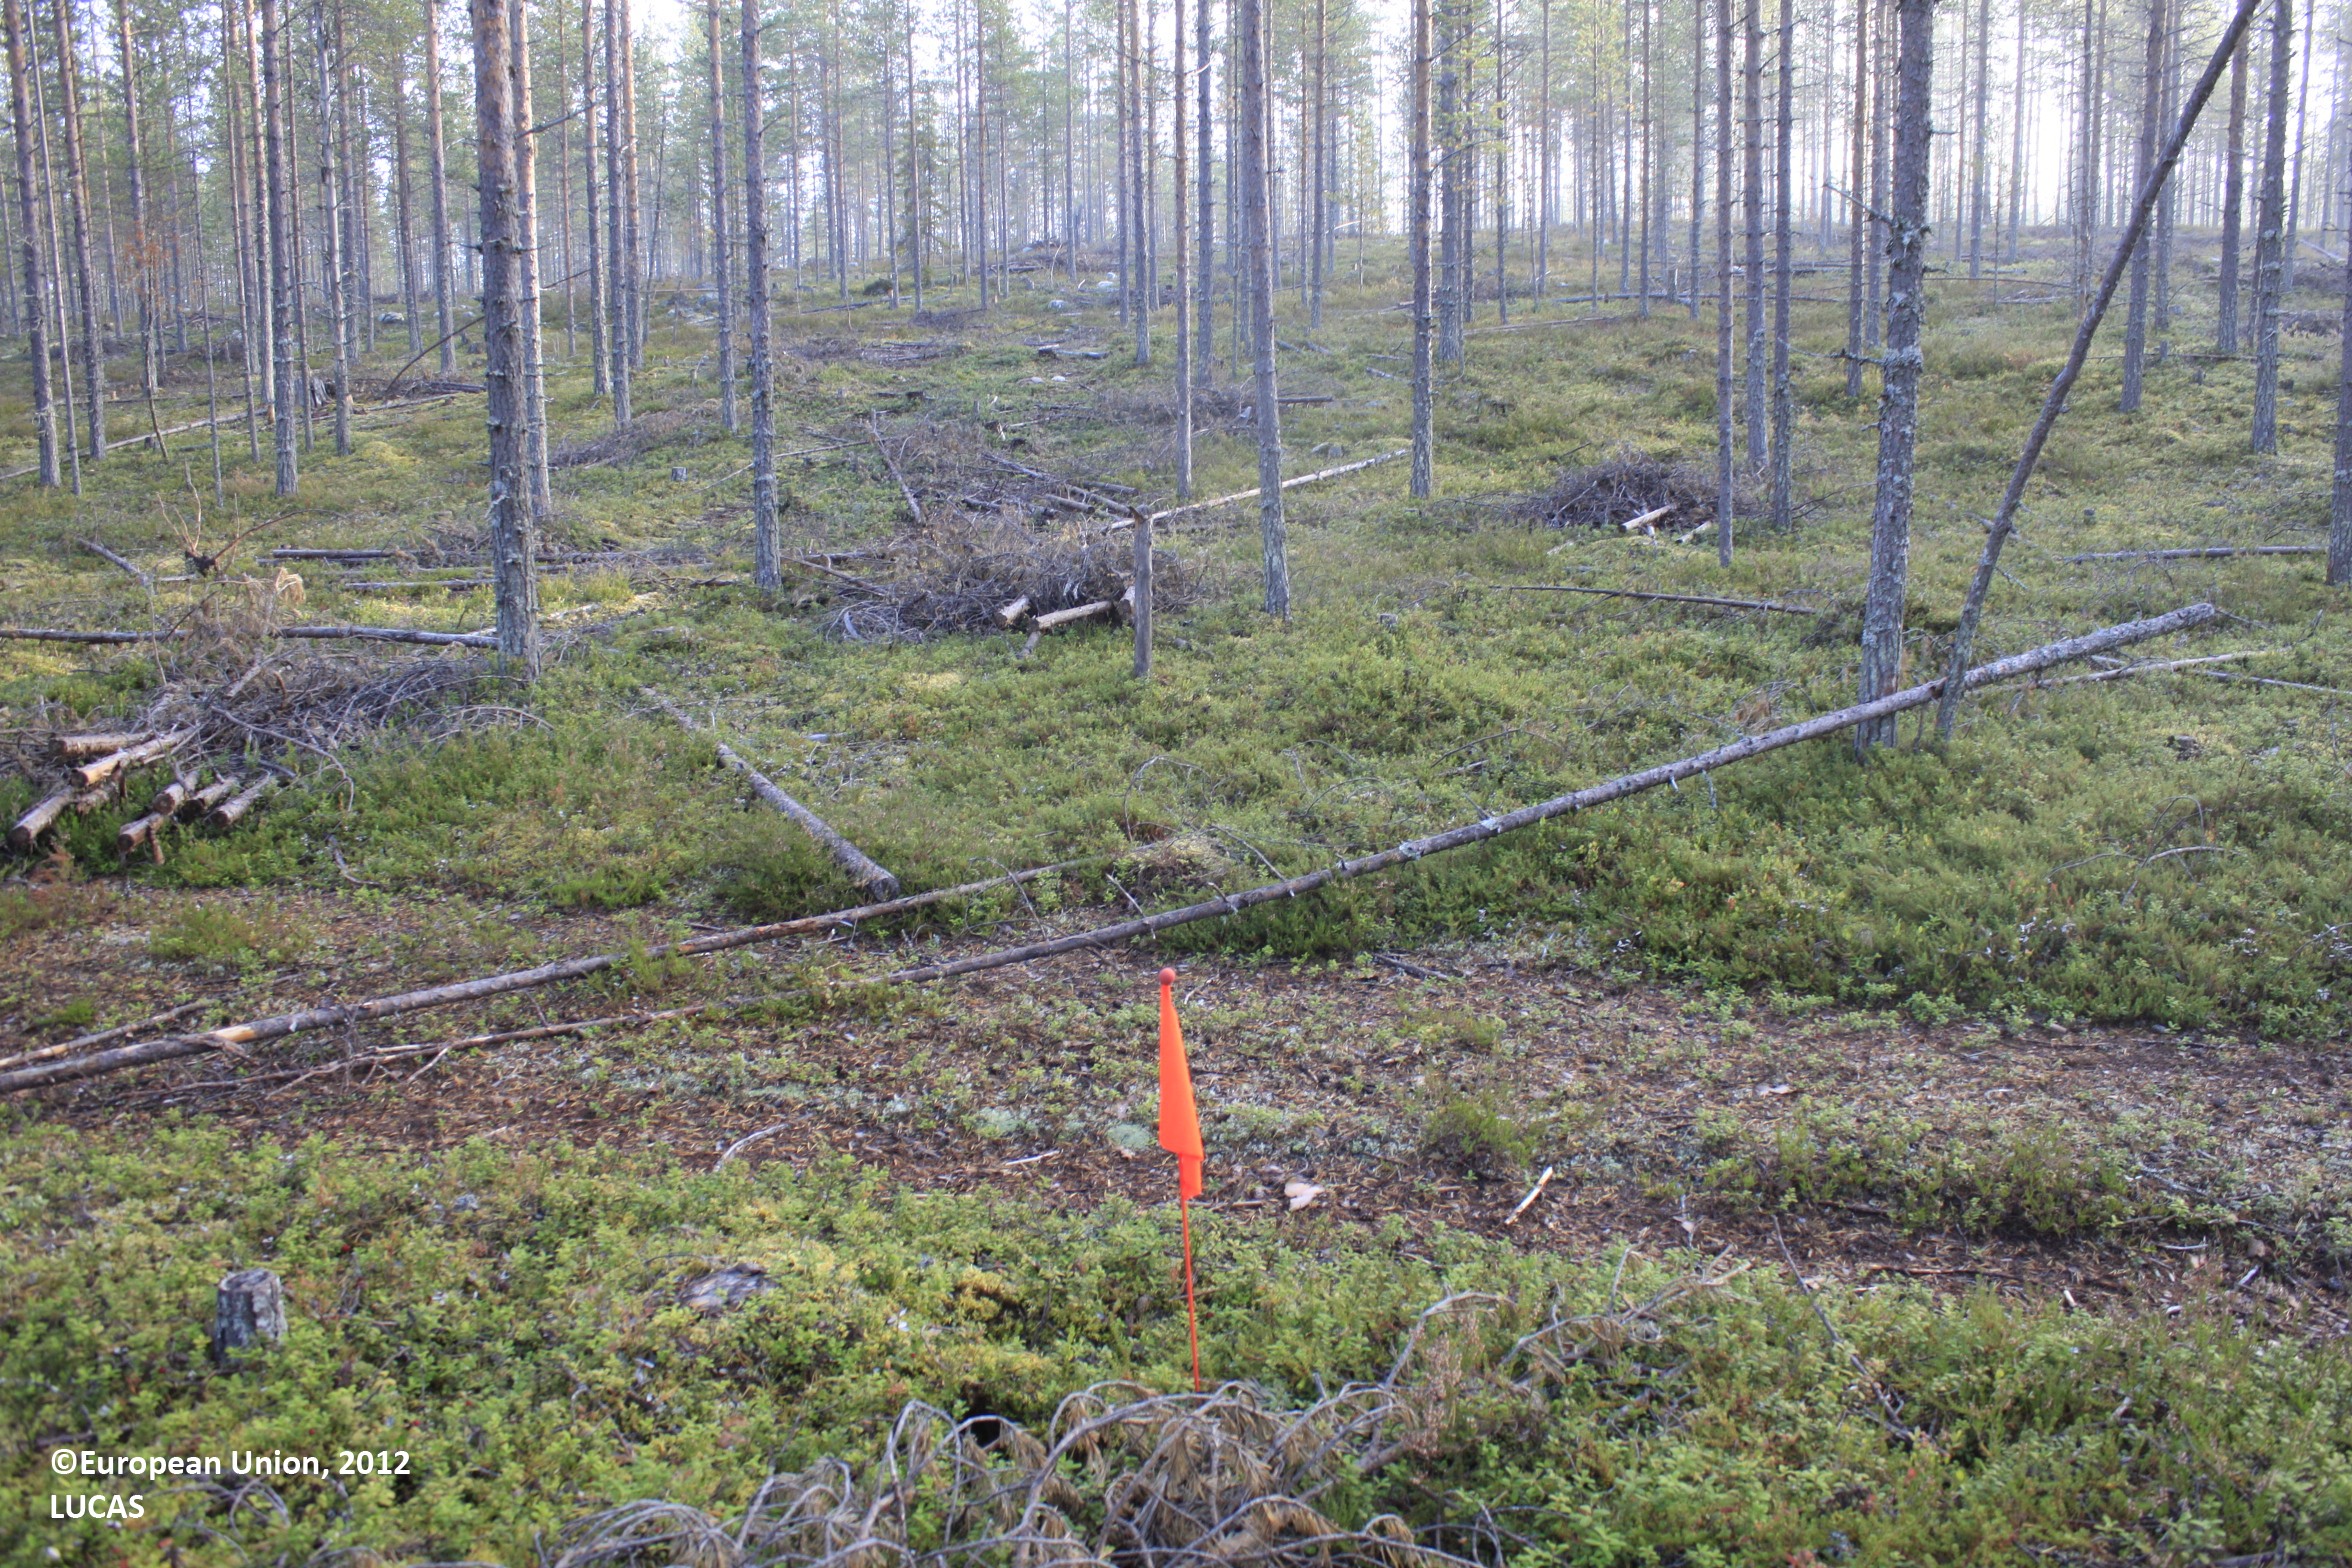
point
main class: Woodland
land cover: Pine dominated coniferous woodland
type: boreal forest
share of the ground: 25 - 50 %
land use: Forestry
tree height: > 5 m
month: September
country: FI
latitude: 65.6194
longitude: 27.0709
